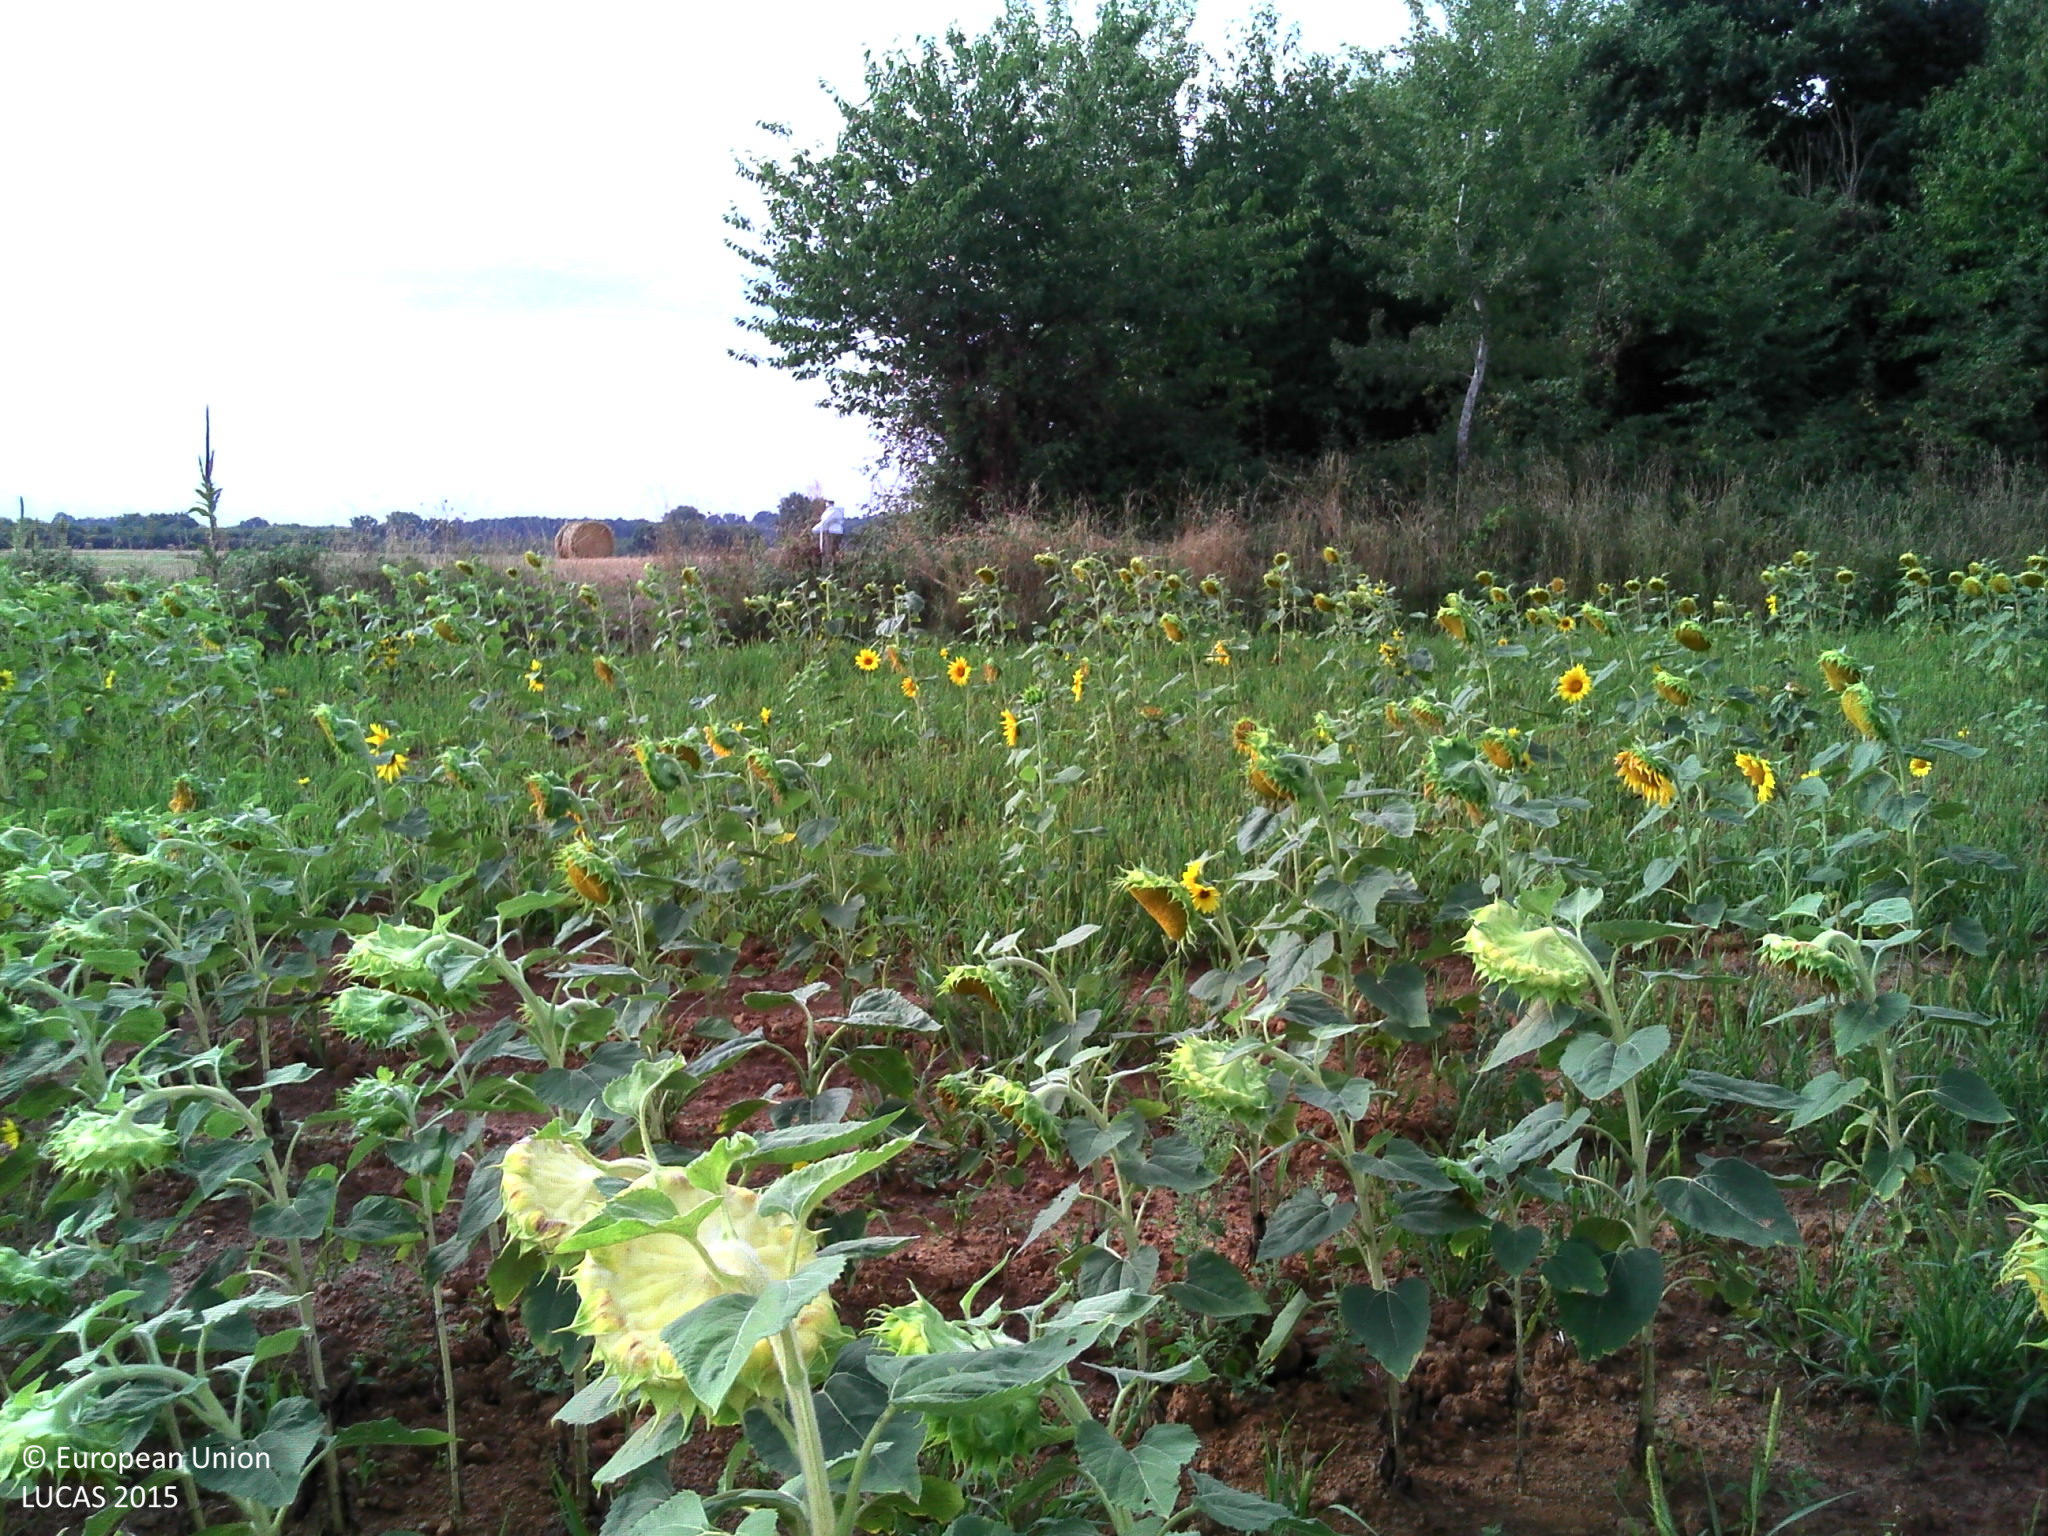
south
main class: Cropland
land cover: Sunflower
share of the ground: > 75 %
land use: Agriculture (excluding fallow land and kitchen gardens)
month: August
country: FR
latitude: 46.1865
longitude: 0.3564
